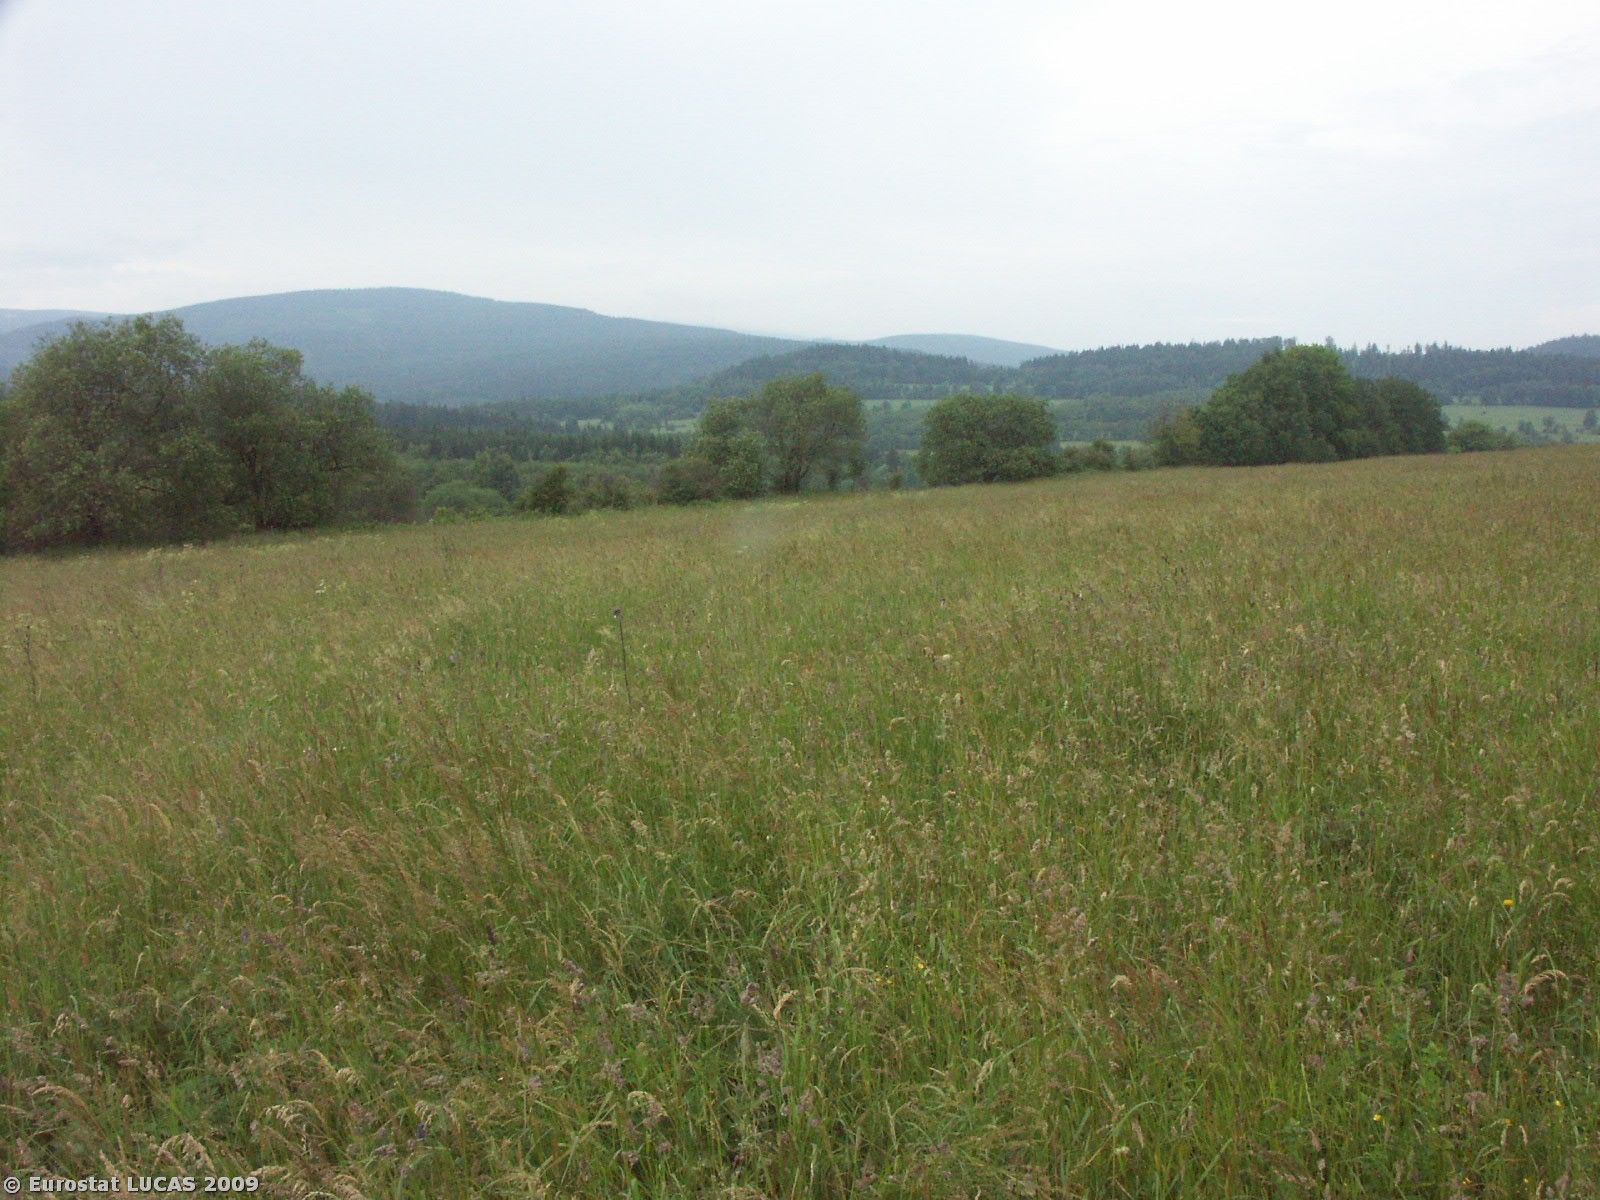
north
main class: Grassland
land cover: Grassland without tree/shrub cover
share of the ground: > 75 %
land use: Agriculture (excluding fallow land and kitchen gardens)
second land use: Nature reserves
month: June
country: CZ
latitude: 49.9554
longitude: 17.2169
